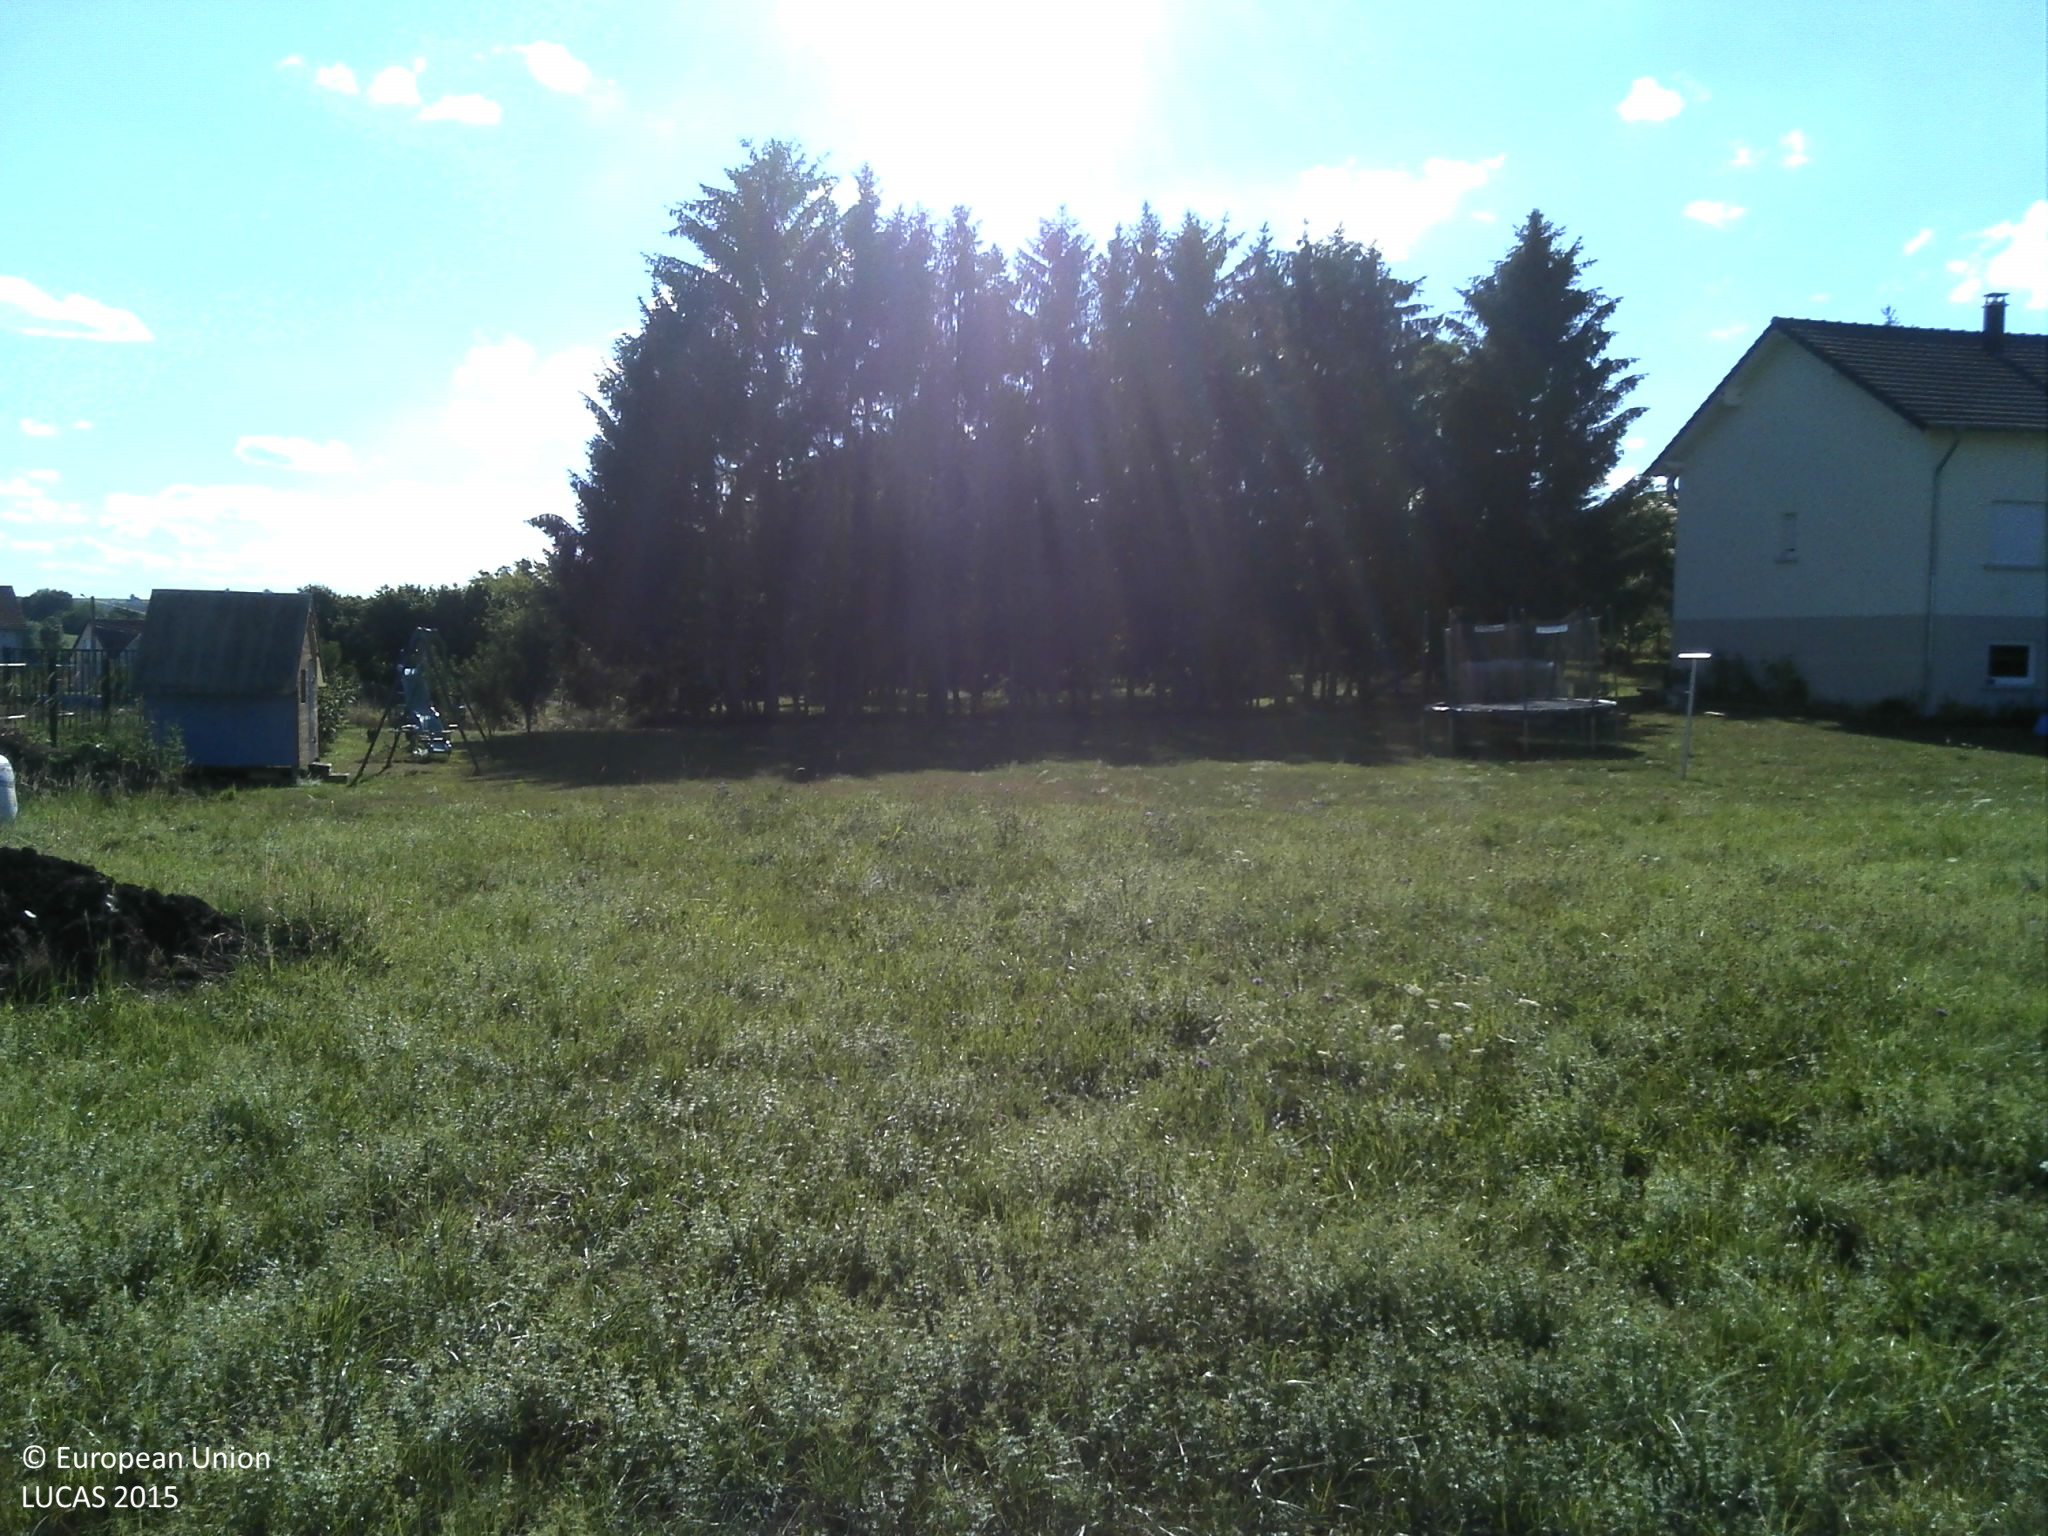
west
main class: Grassland
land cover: Grassland without tree/shrub cover
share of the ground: > 75 %
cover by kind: herbaceous plants 100 %
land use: Residential
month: July
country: FR
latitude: 49.0727
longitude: 7.3038
